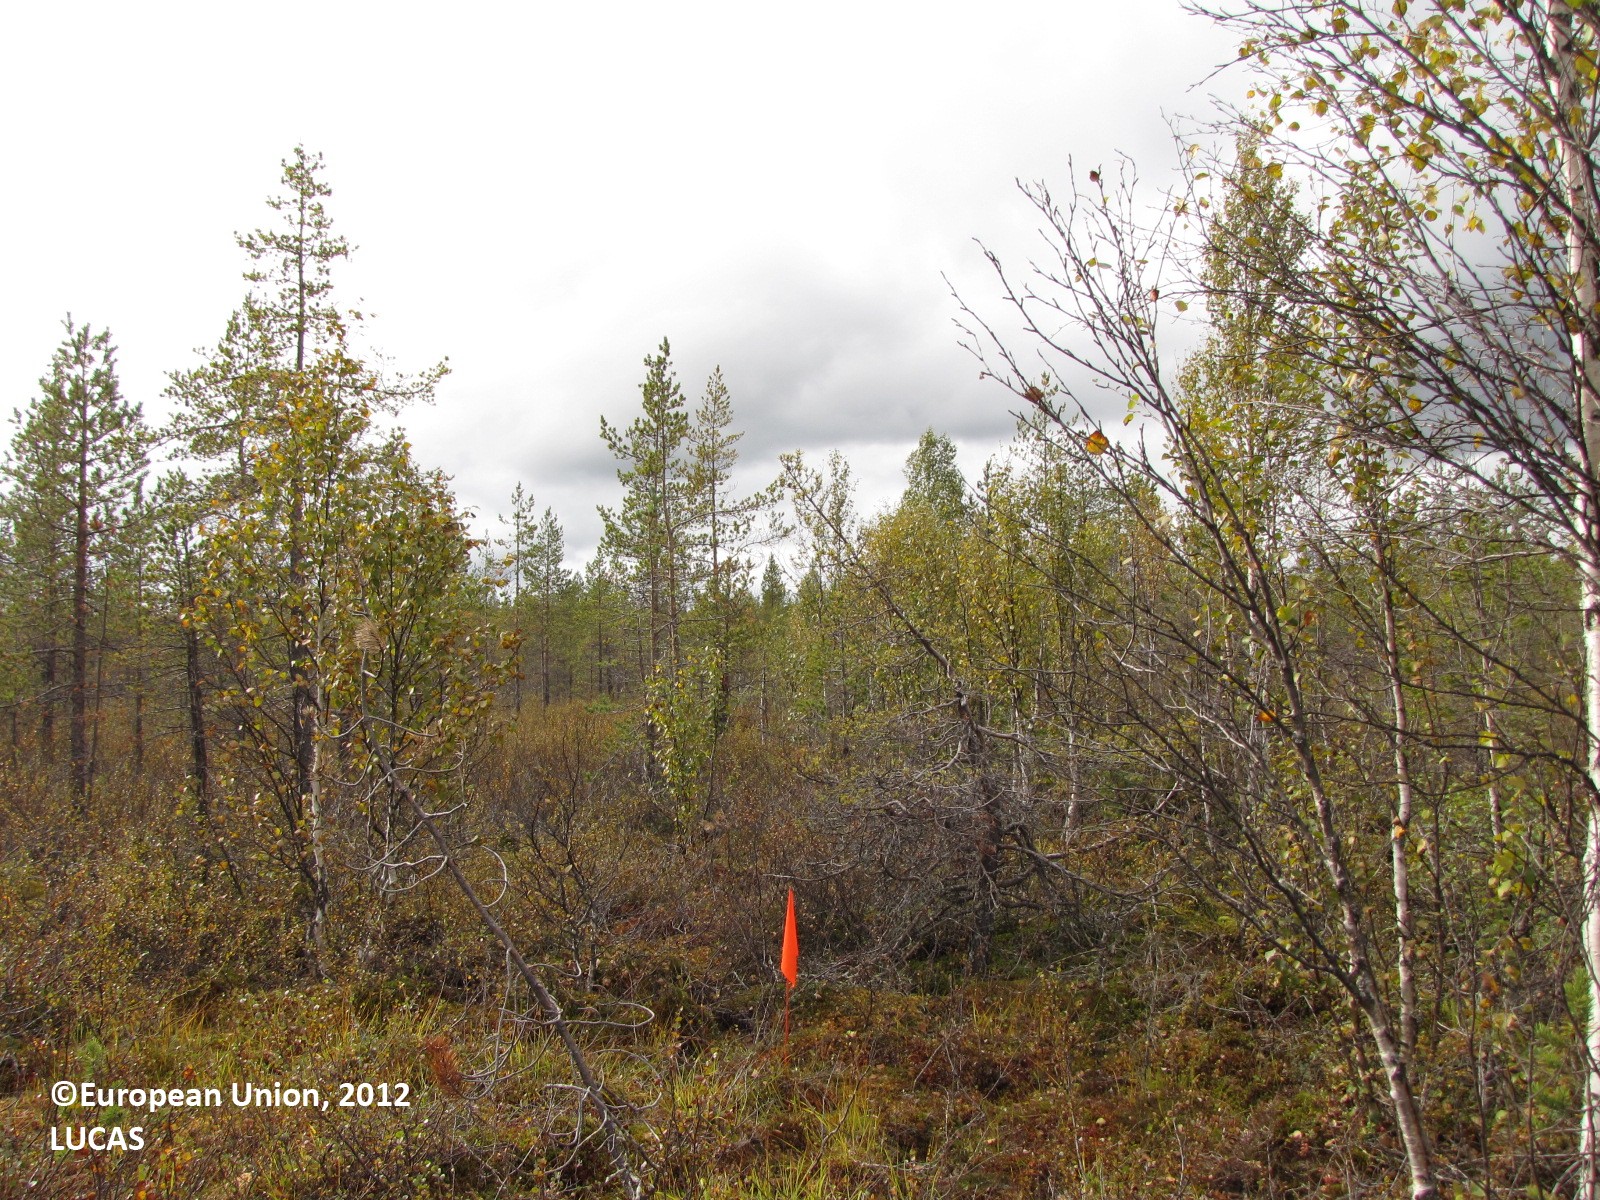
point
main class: Woodland
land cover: Pine dominated mixed woodland
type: boreal forest
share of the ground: 25 - 50 %
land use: Forestry
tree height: > 5 m
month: September
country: FI
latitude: 67.2227
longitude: 23.9838
